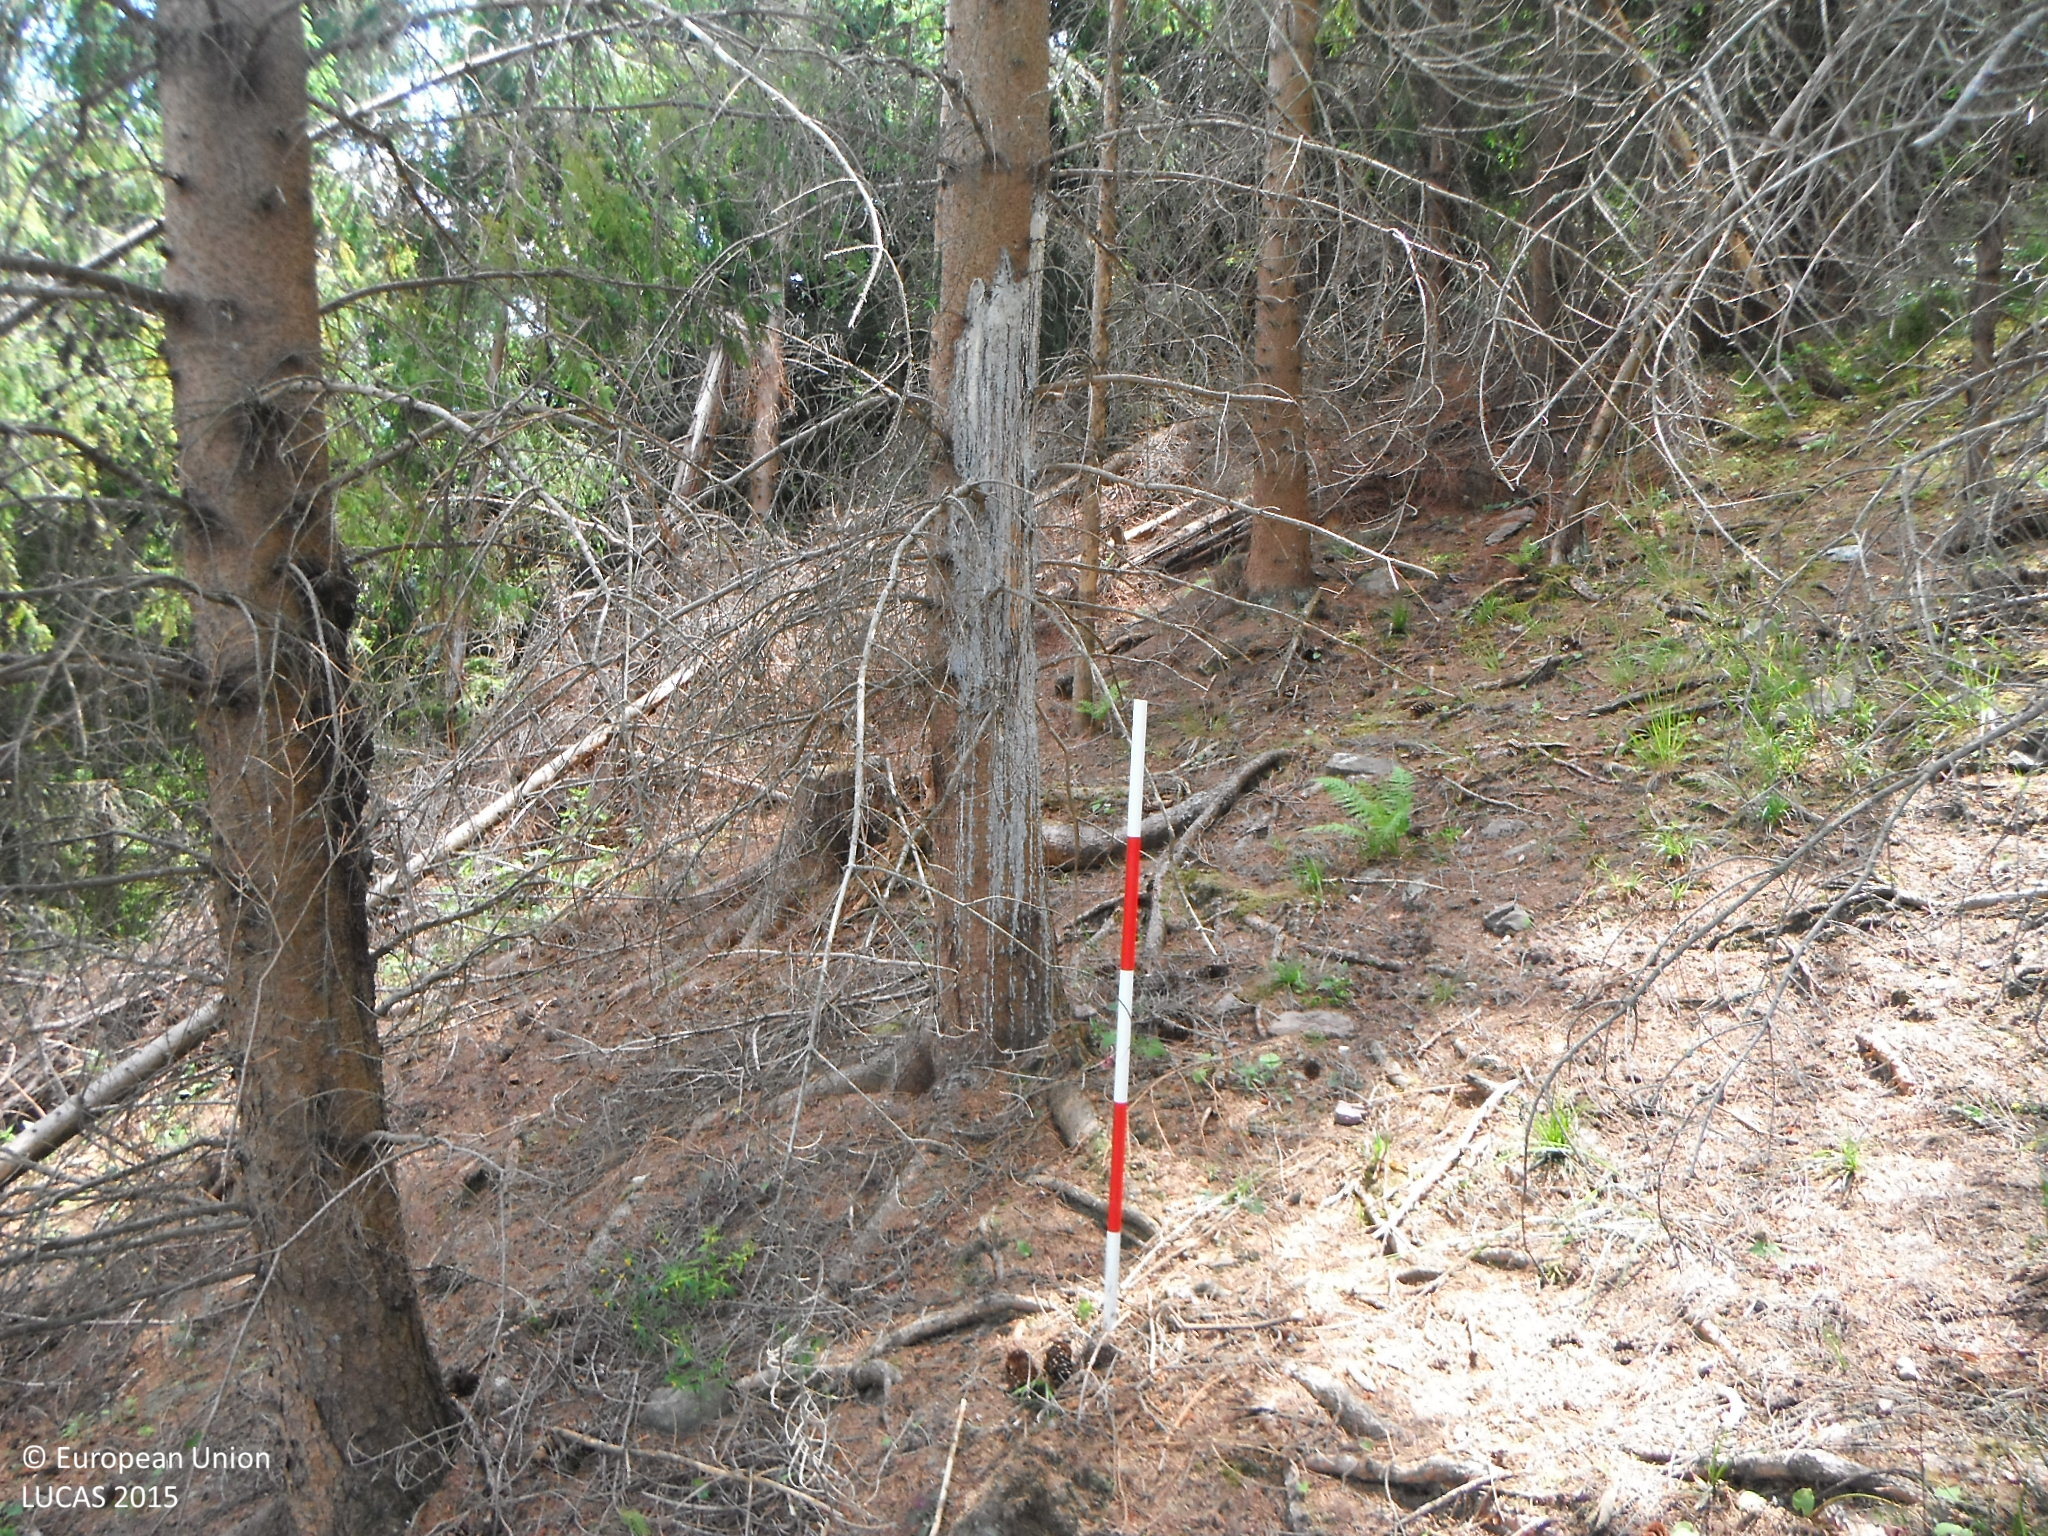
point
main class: Woodland
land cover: Spruce dominated coniferous woodland
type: alpine coniferous forest
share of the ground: > 75 %
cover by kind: coniferous forest trees 85 %, consolidated bare surface 10 %, lichens and mosses 5 %
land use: Forestry
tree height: > 5 m
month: July
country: SK
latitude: 48.9812
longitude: 20.2123
